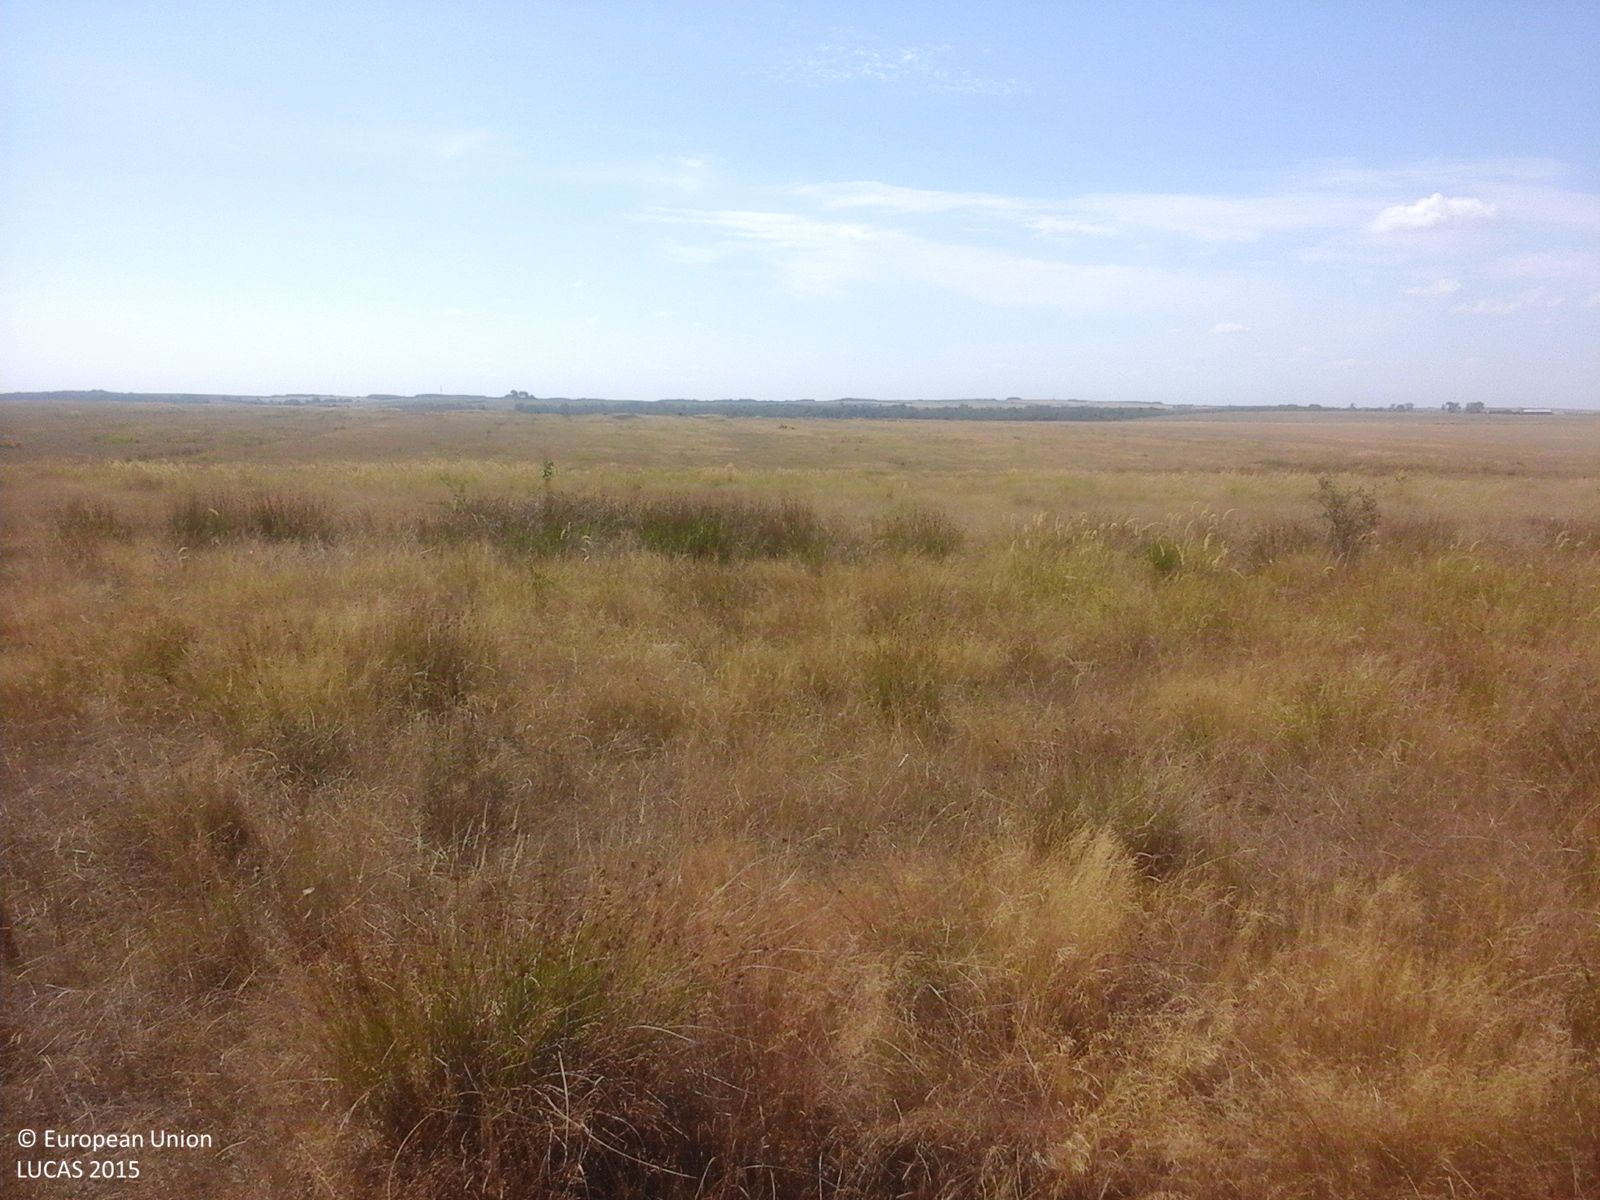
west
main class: Grassland
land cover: Spontaneously vegetated surfaces
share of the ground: > 75 %
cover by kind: herbaceous plants 100 %
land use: Fallow land
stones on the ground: < 10 %
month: August
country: RO
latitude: 45.3621
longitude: 21.6896
